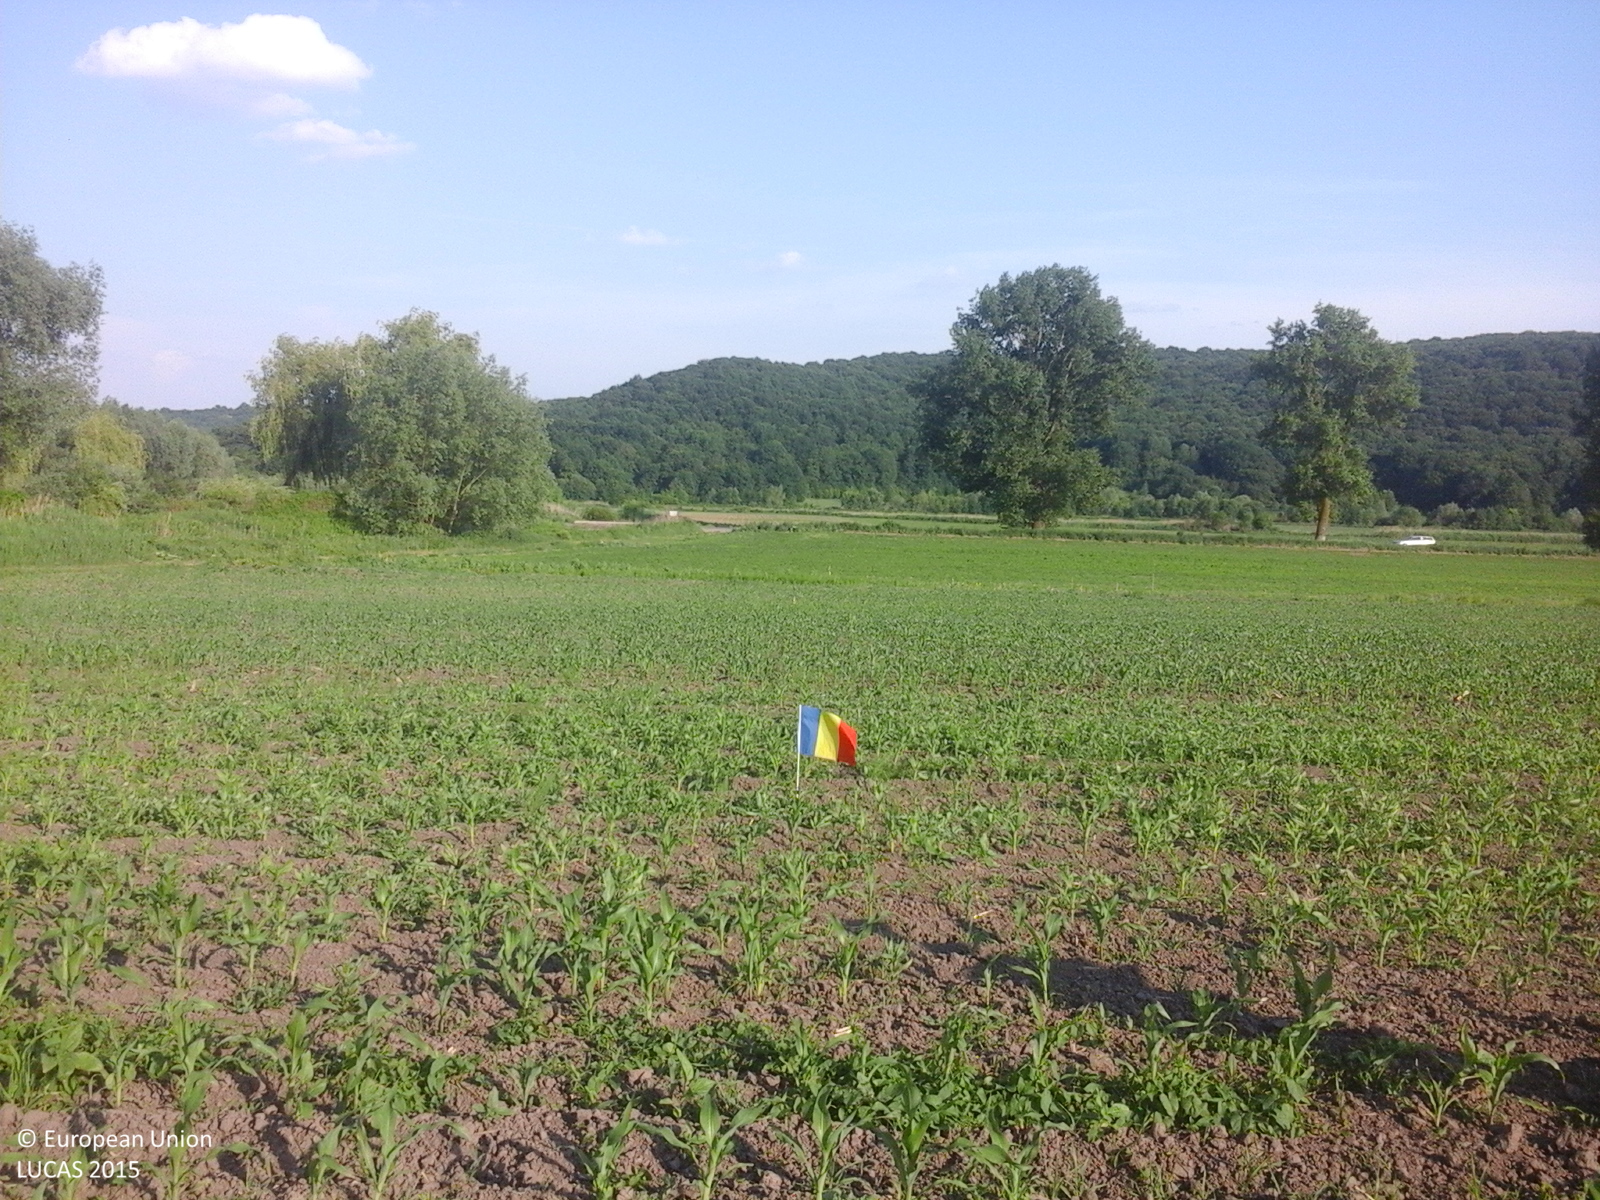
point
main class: Cropland
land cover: Maize
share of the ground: 10 - 25 %
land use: Agriculture (excluding fallow land and kitchen gardens)
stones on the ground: < 10 %
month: June
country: RO
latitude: 46.9673
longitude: 26.7445
